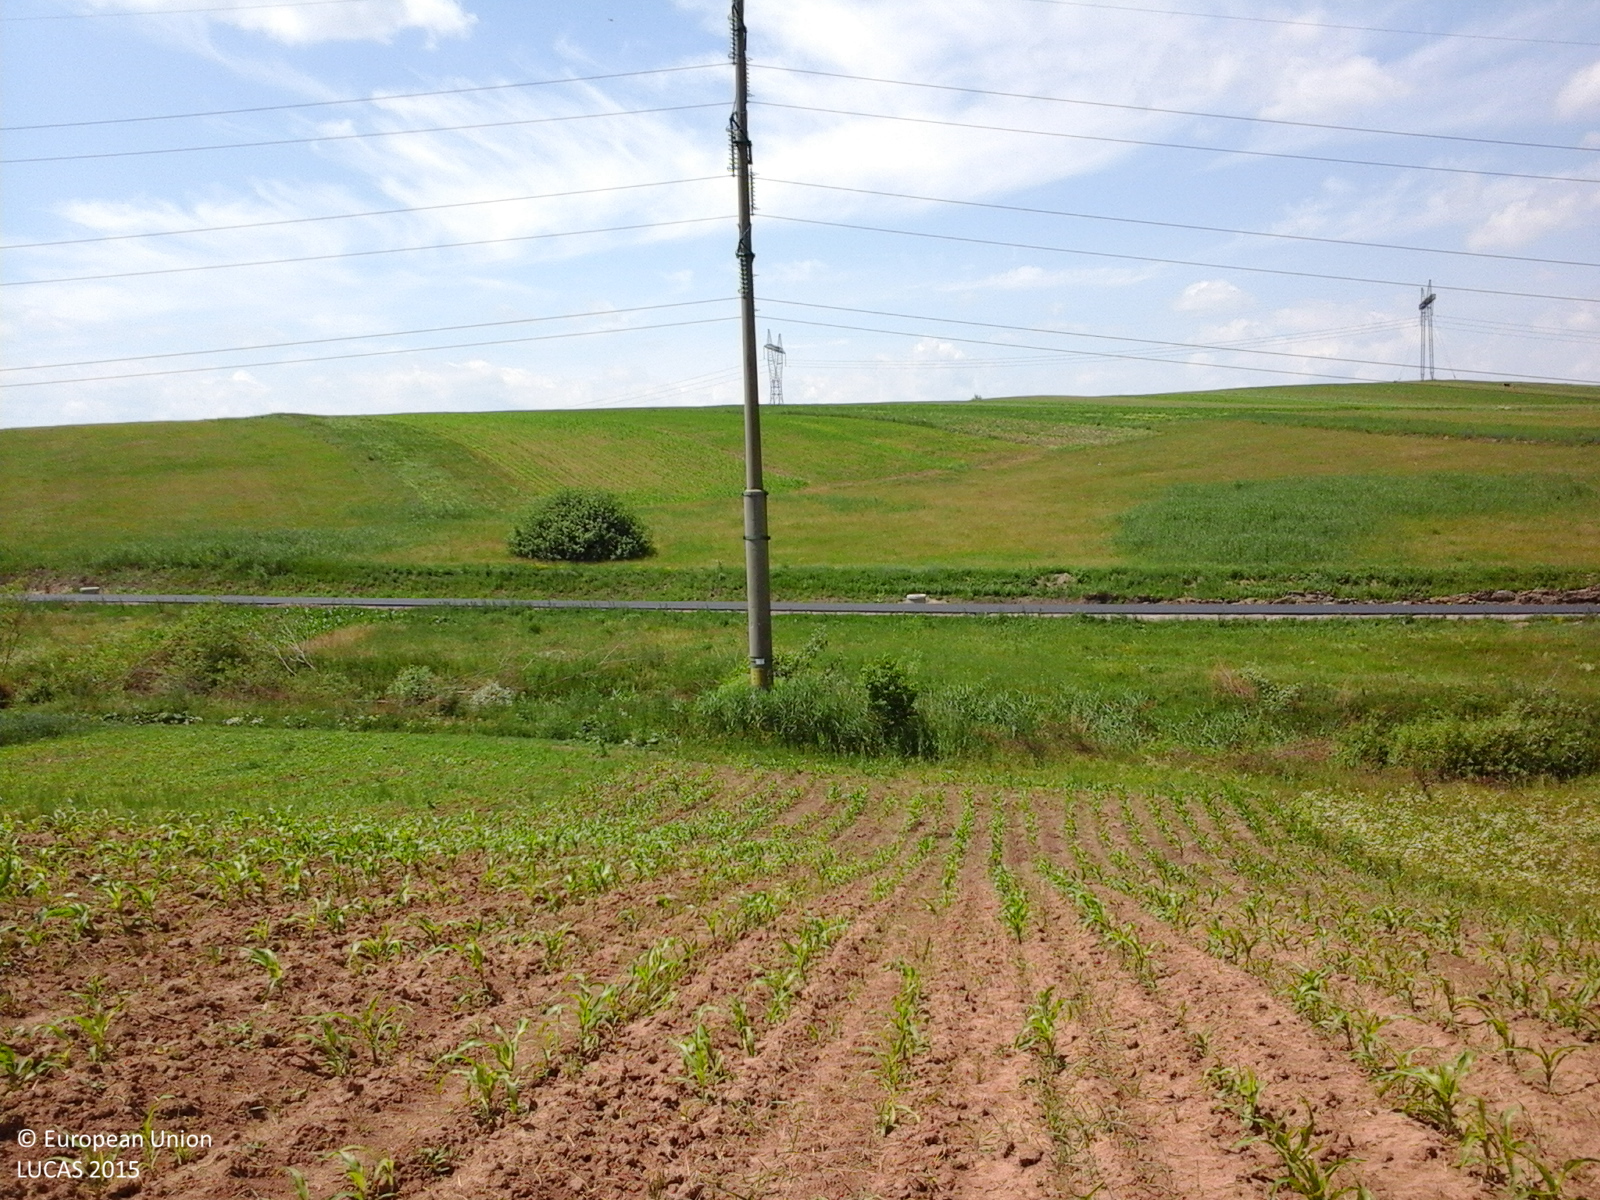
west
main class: Cropland
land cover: Maize
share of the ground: 10 - 25 %
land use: Agriculture (excluding fallow land and kitchen gardens)
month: June
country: RO
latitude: 47.5529
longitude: 26.2820
